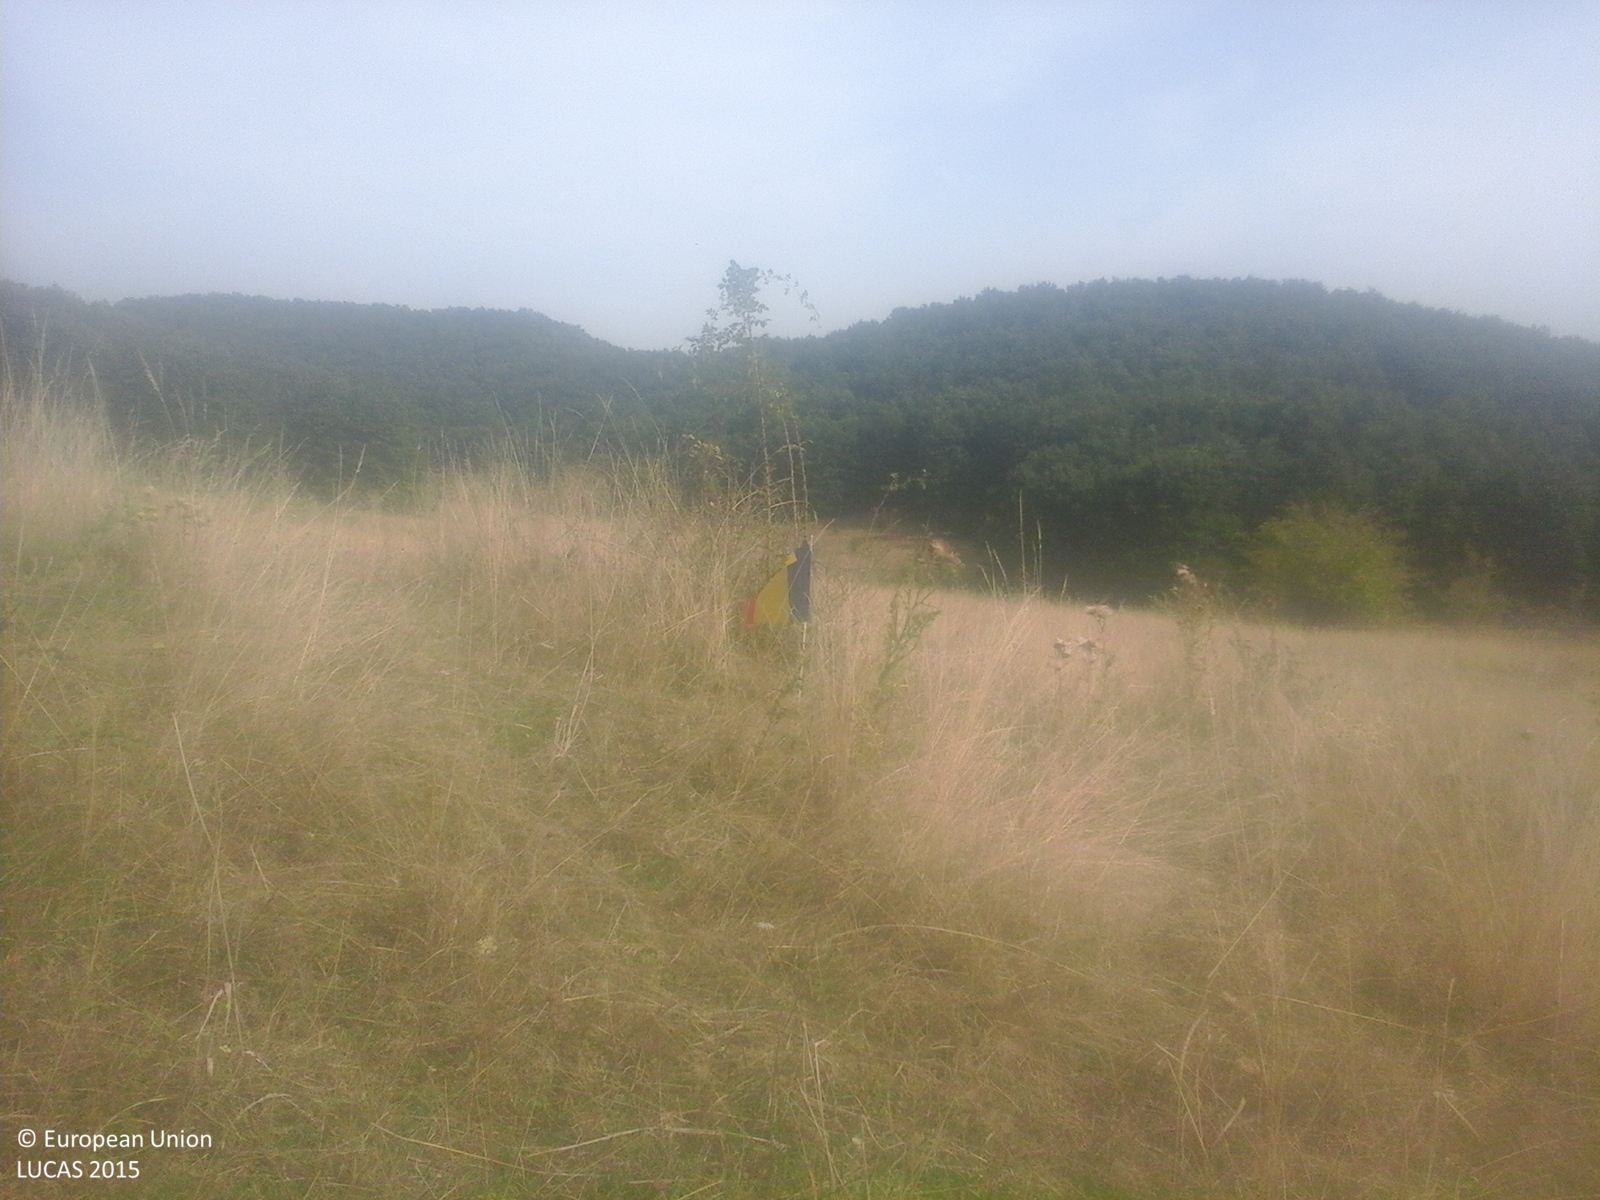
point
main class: Grassland
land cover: Grassland with sparse tree/shrub cover
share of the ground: > 75 %
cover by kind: herbaceous plants 85 %, shrubs 10 %, broadleaved forest trees 5 %
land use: Agriculture (excluding fallow land and kitchen gardens)
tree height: < 5 m
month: September
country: RO
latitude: 47.0485
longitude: 23.5912
